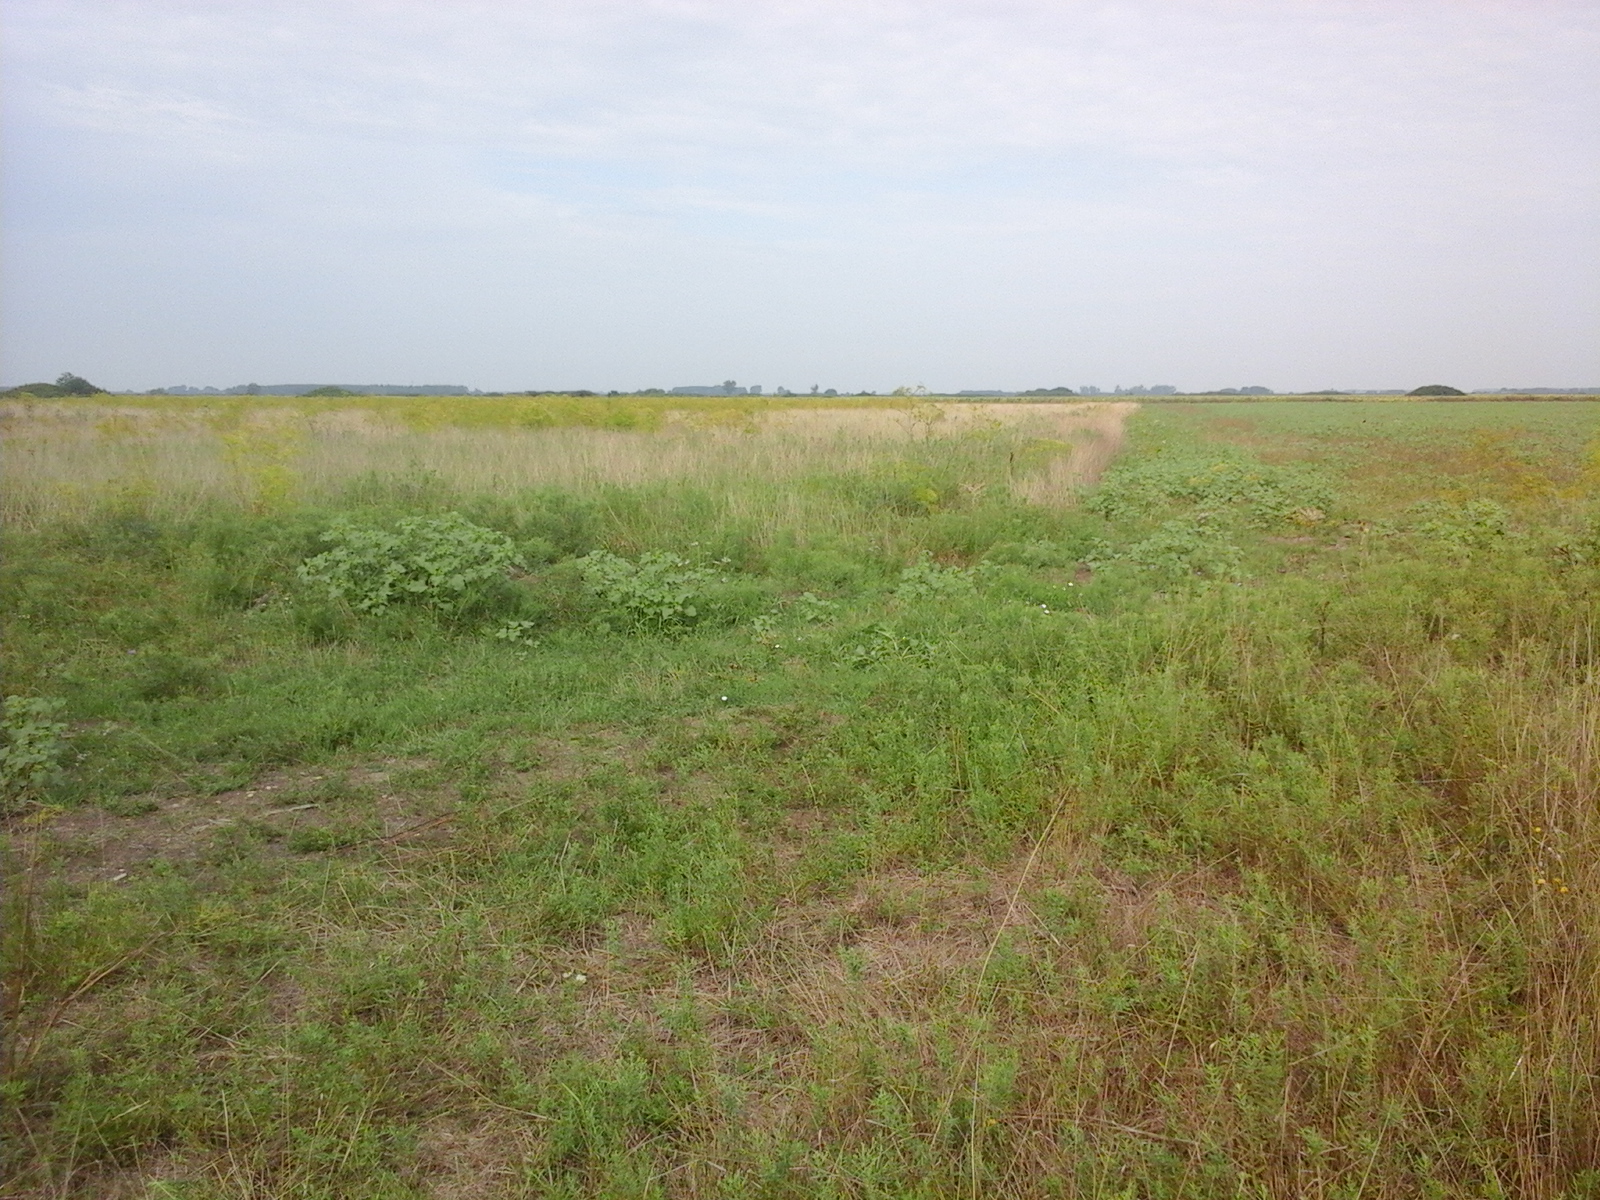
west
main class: Cropland
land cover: Soya
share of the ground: > 75 %
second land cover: Sunflower
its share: > 75 %
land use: Agriculture (excluding fallow land and kitchen gardens)
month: August
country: RO
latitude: 46.7805
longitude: 21.5263
